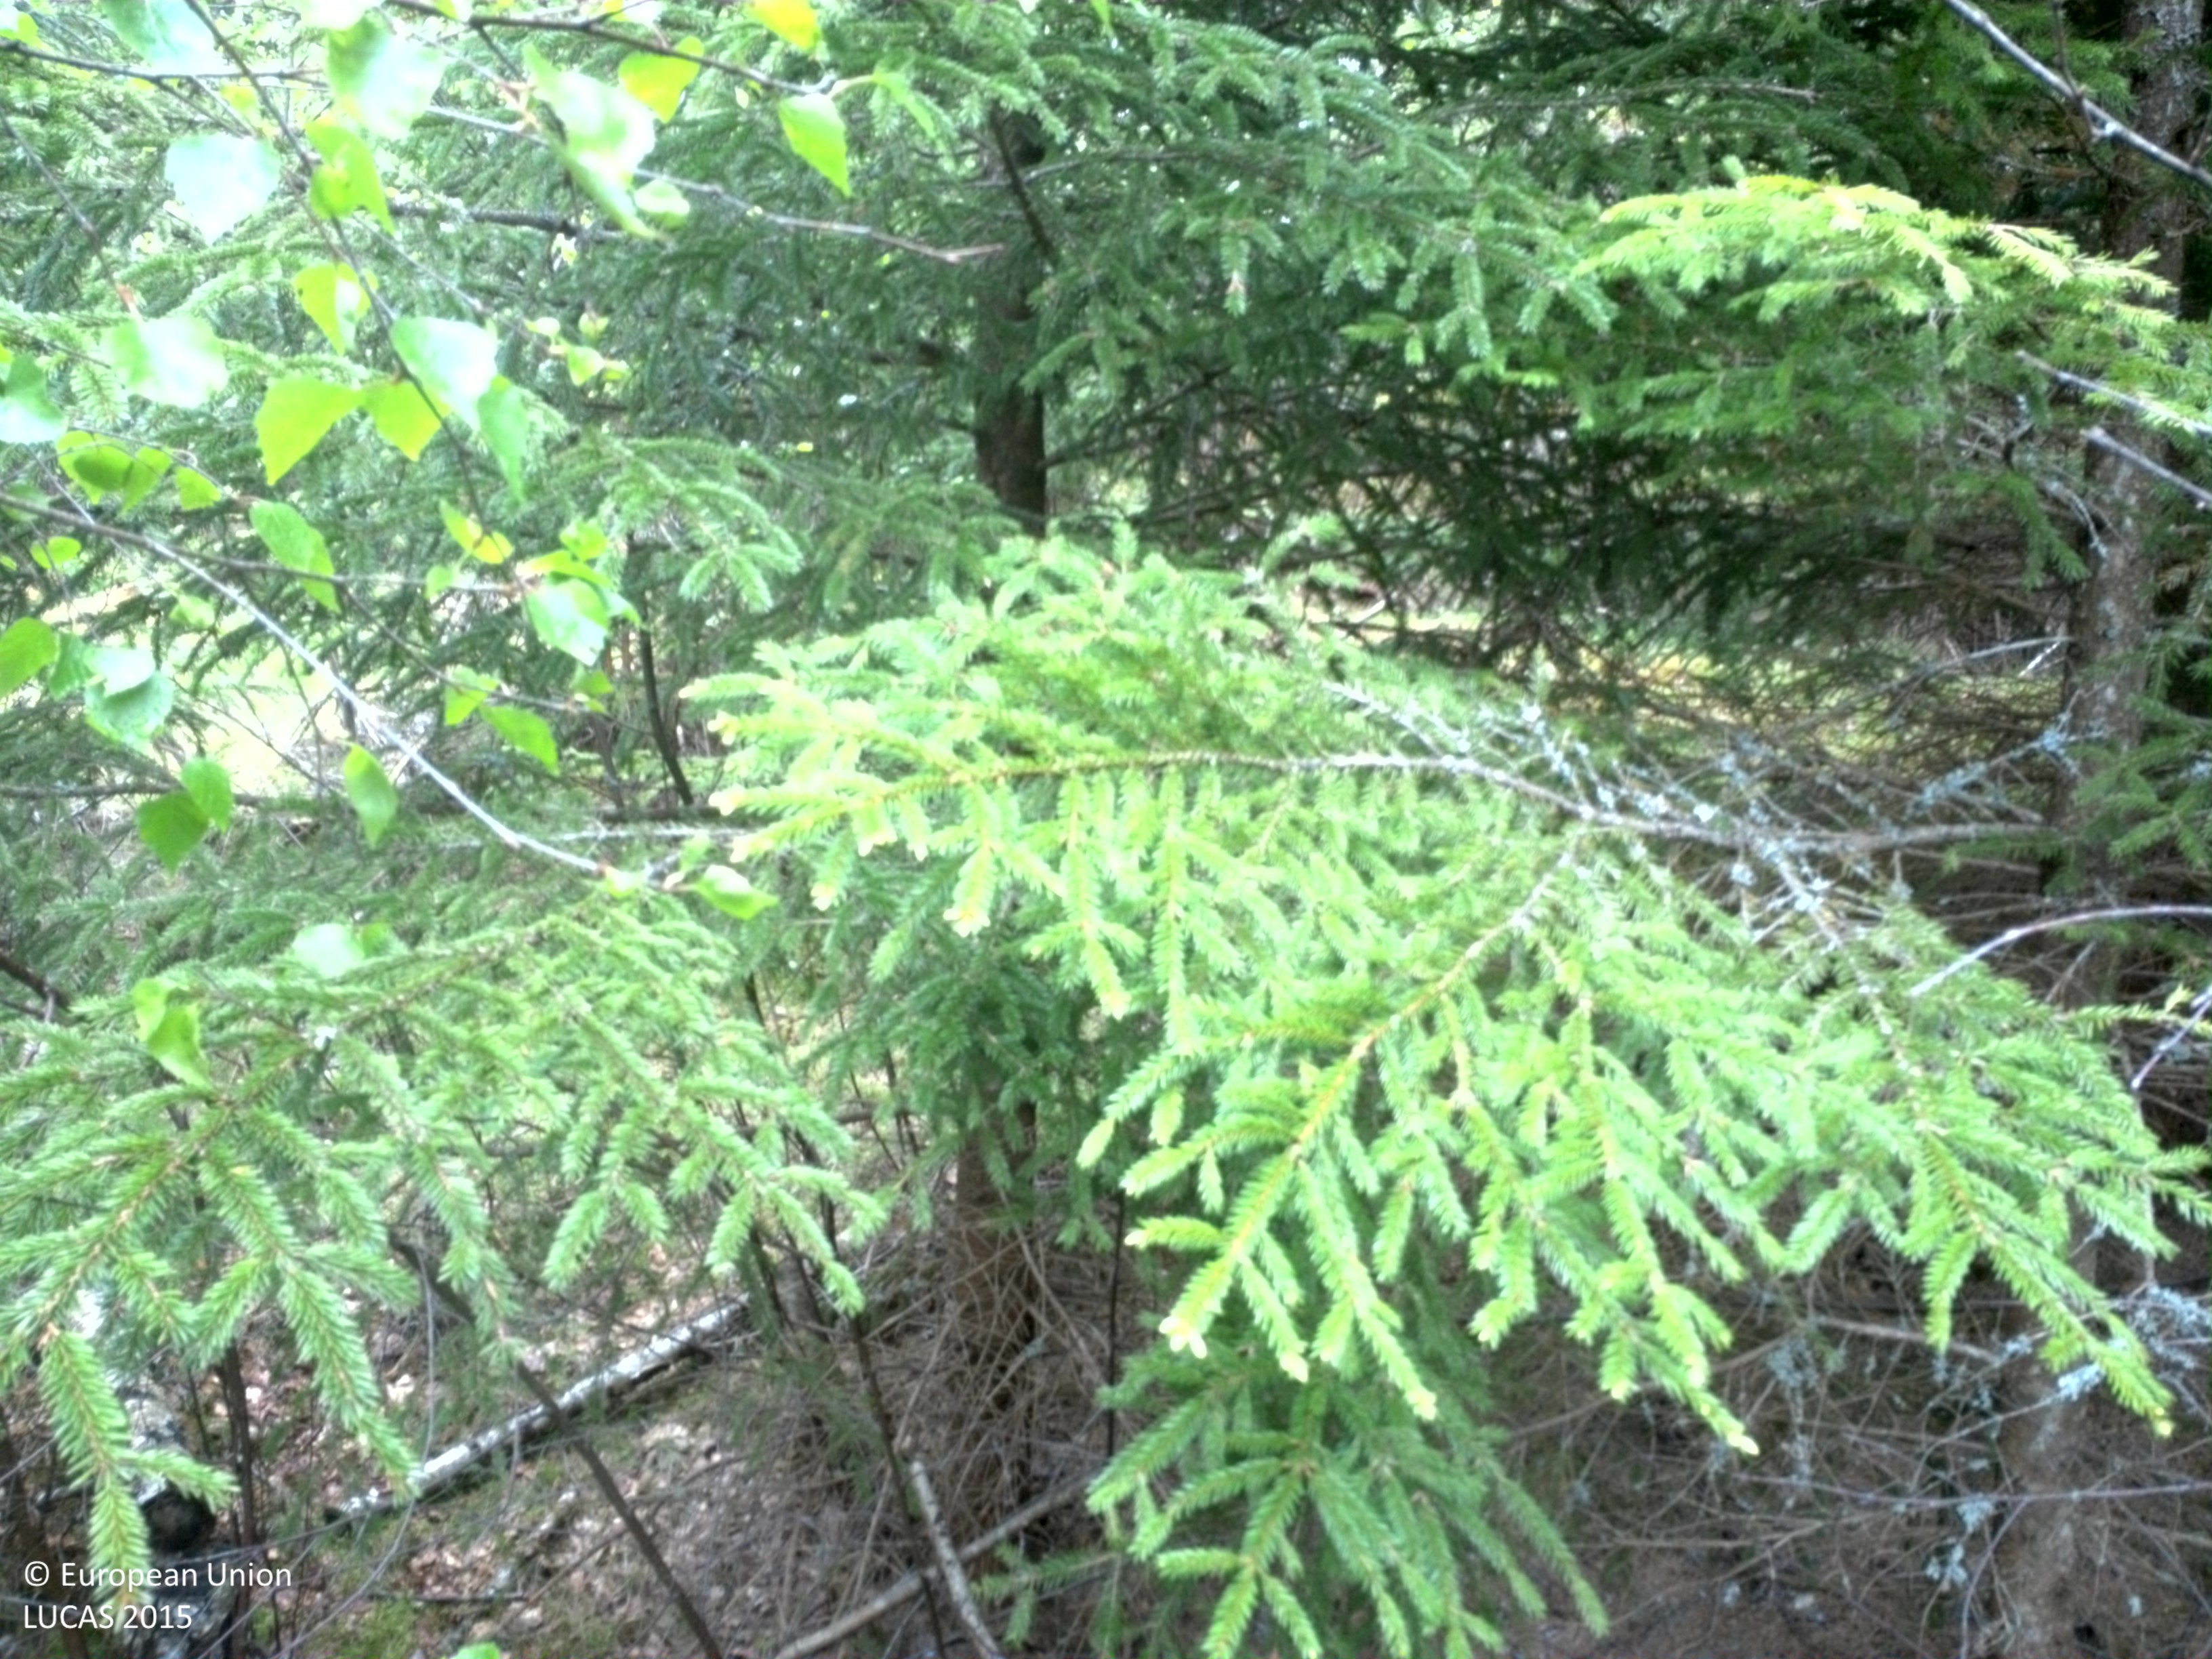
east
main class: Woodland
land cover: Spruce dominated mixed woodland
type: boreal forest
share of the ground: > 75 %
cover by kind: coniferous forest trees 60 %, broadleaved forest trees 20 %, herbaceous plants 10 %, lichens and mosses 10 %
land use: Forestry
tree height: < 5 m
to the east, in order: Spruce dominated mixed woodland; Inland marshes; Spruce dominated mixed woodland; Dry stone walls; Spruce dominated coniferous woodland; Broadleaved woodland
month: May
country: SE
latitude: 56.5898
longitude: 15.1276
